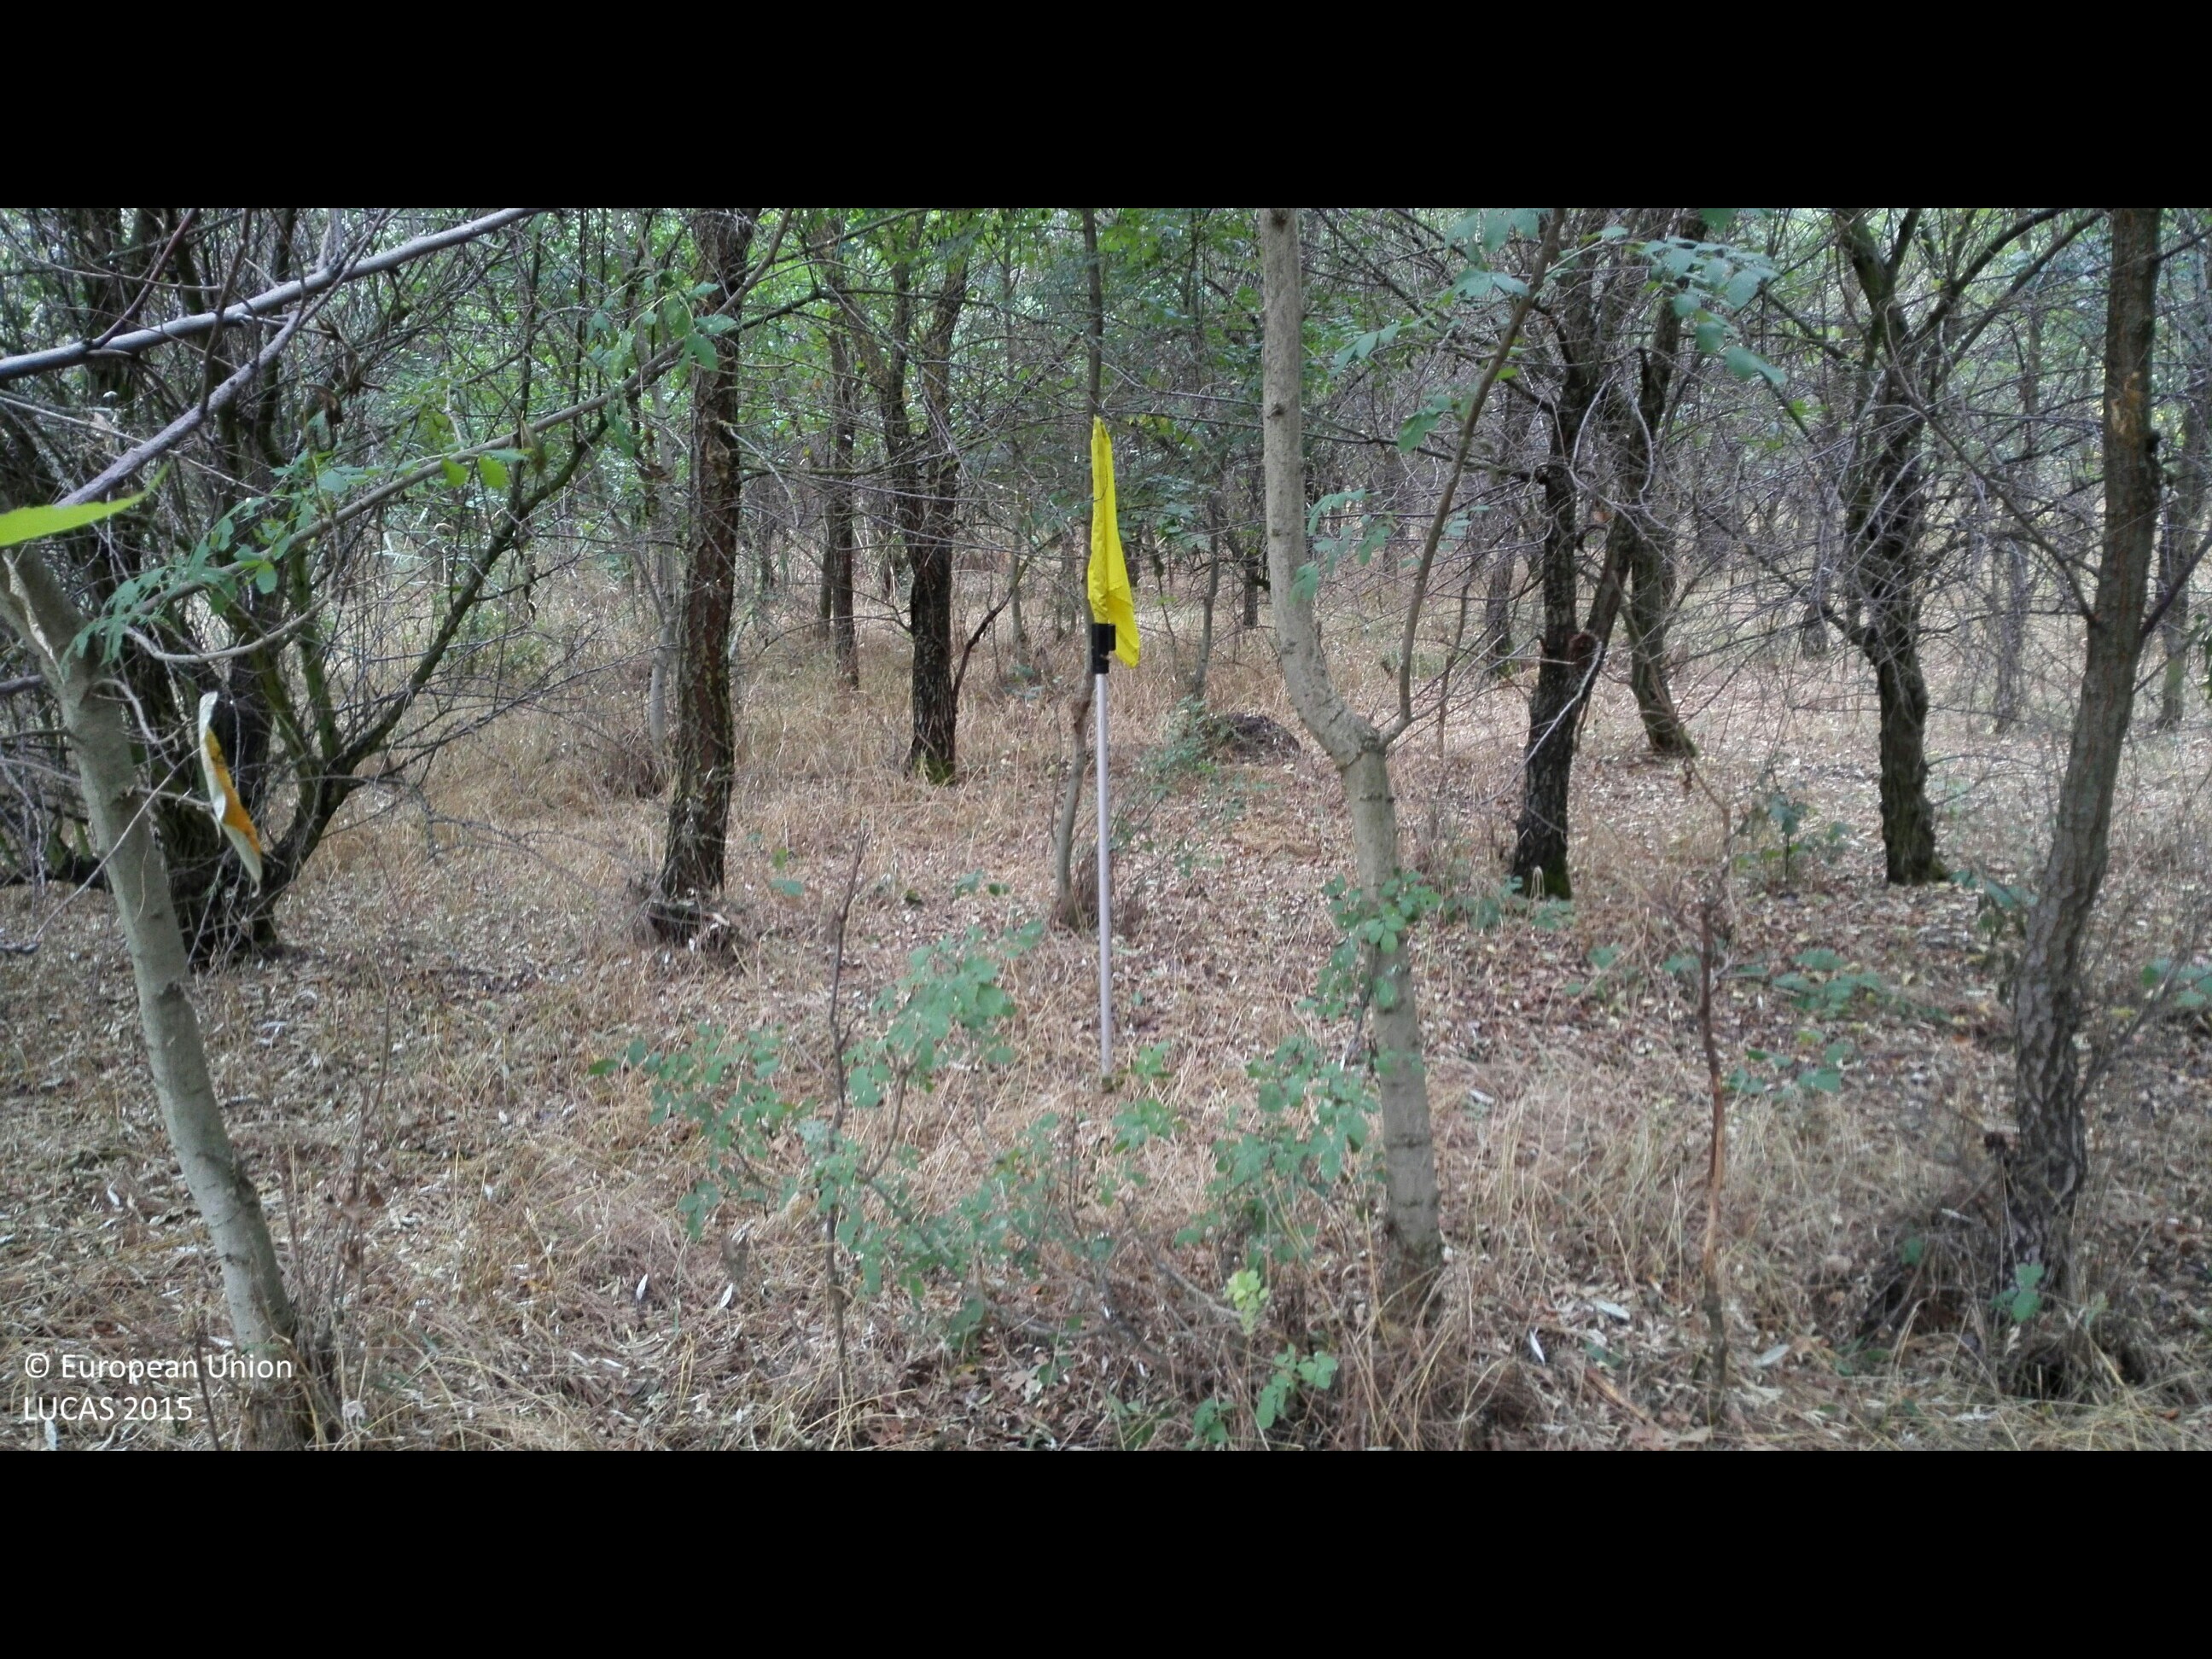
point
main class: Woodland
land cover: Broadleaved woodland
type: acidophilous oak and oak-birch forest
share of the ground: > 75 %
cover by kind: broadleaved forest trees 95 %, herbaceous plants 5 %
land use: Forestry
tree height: > 5 m
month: August
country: HU
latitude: 47.2457
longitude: 21.7638
